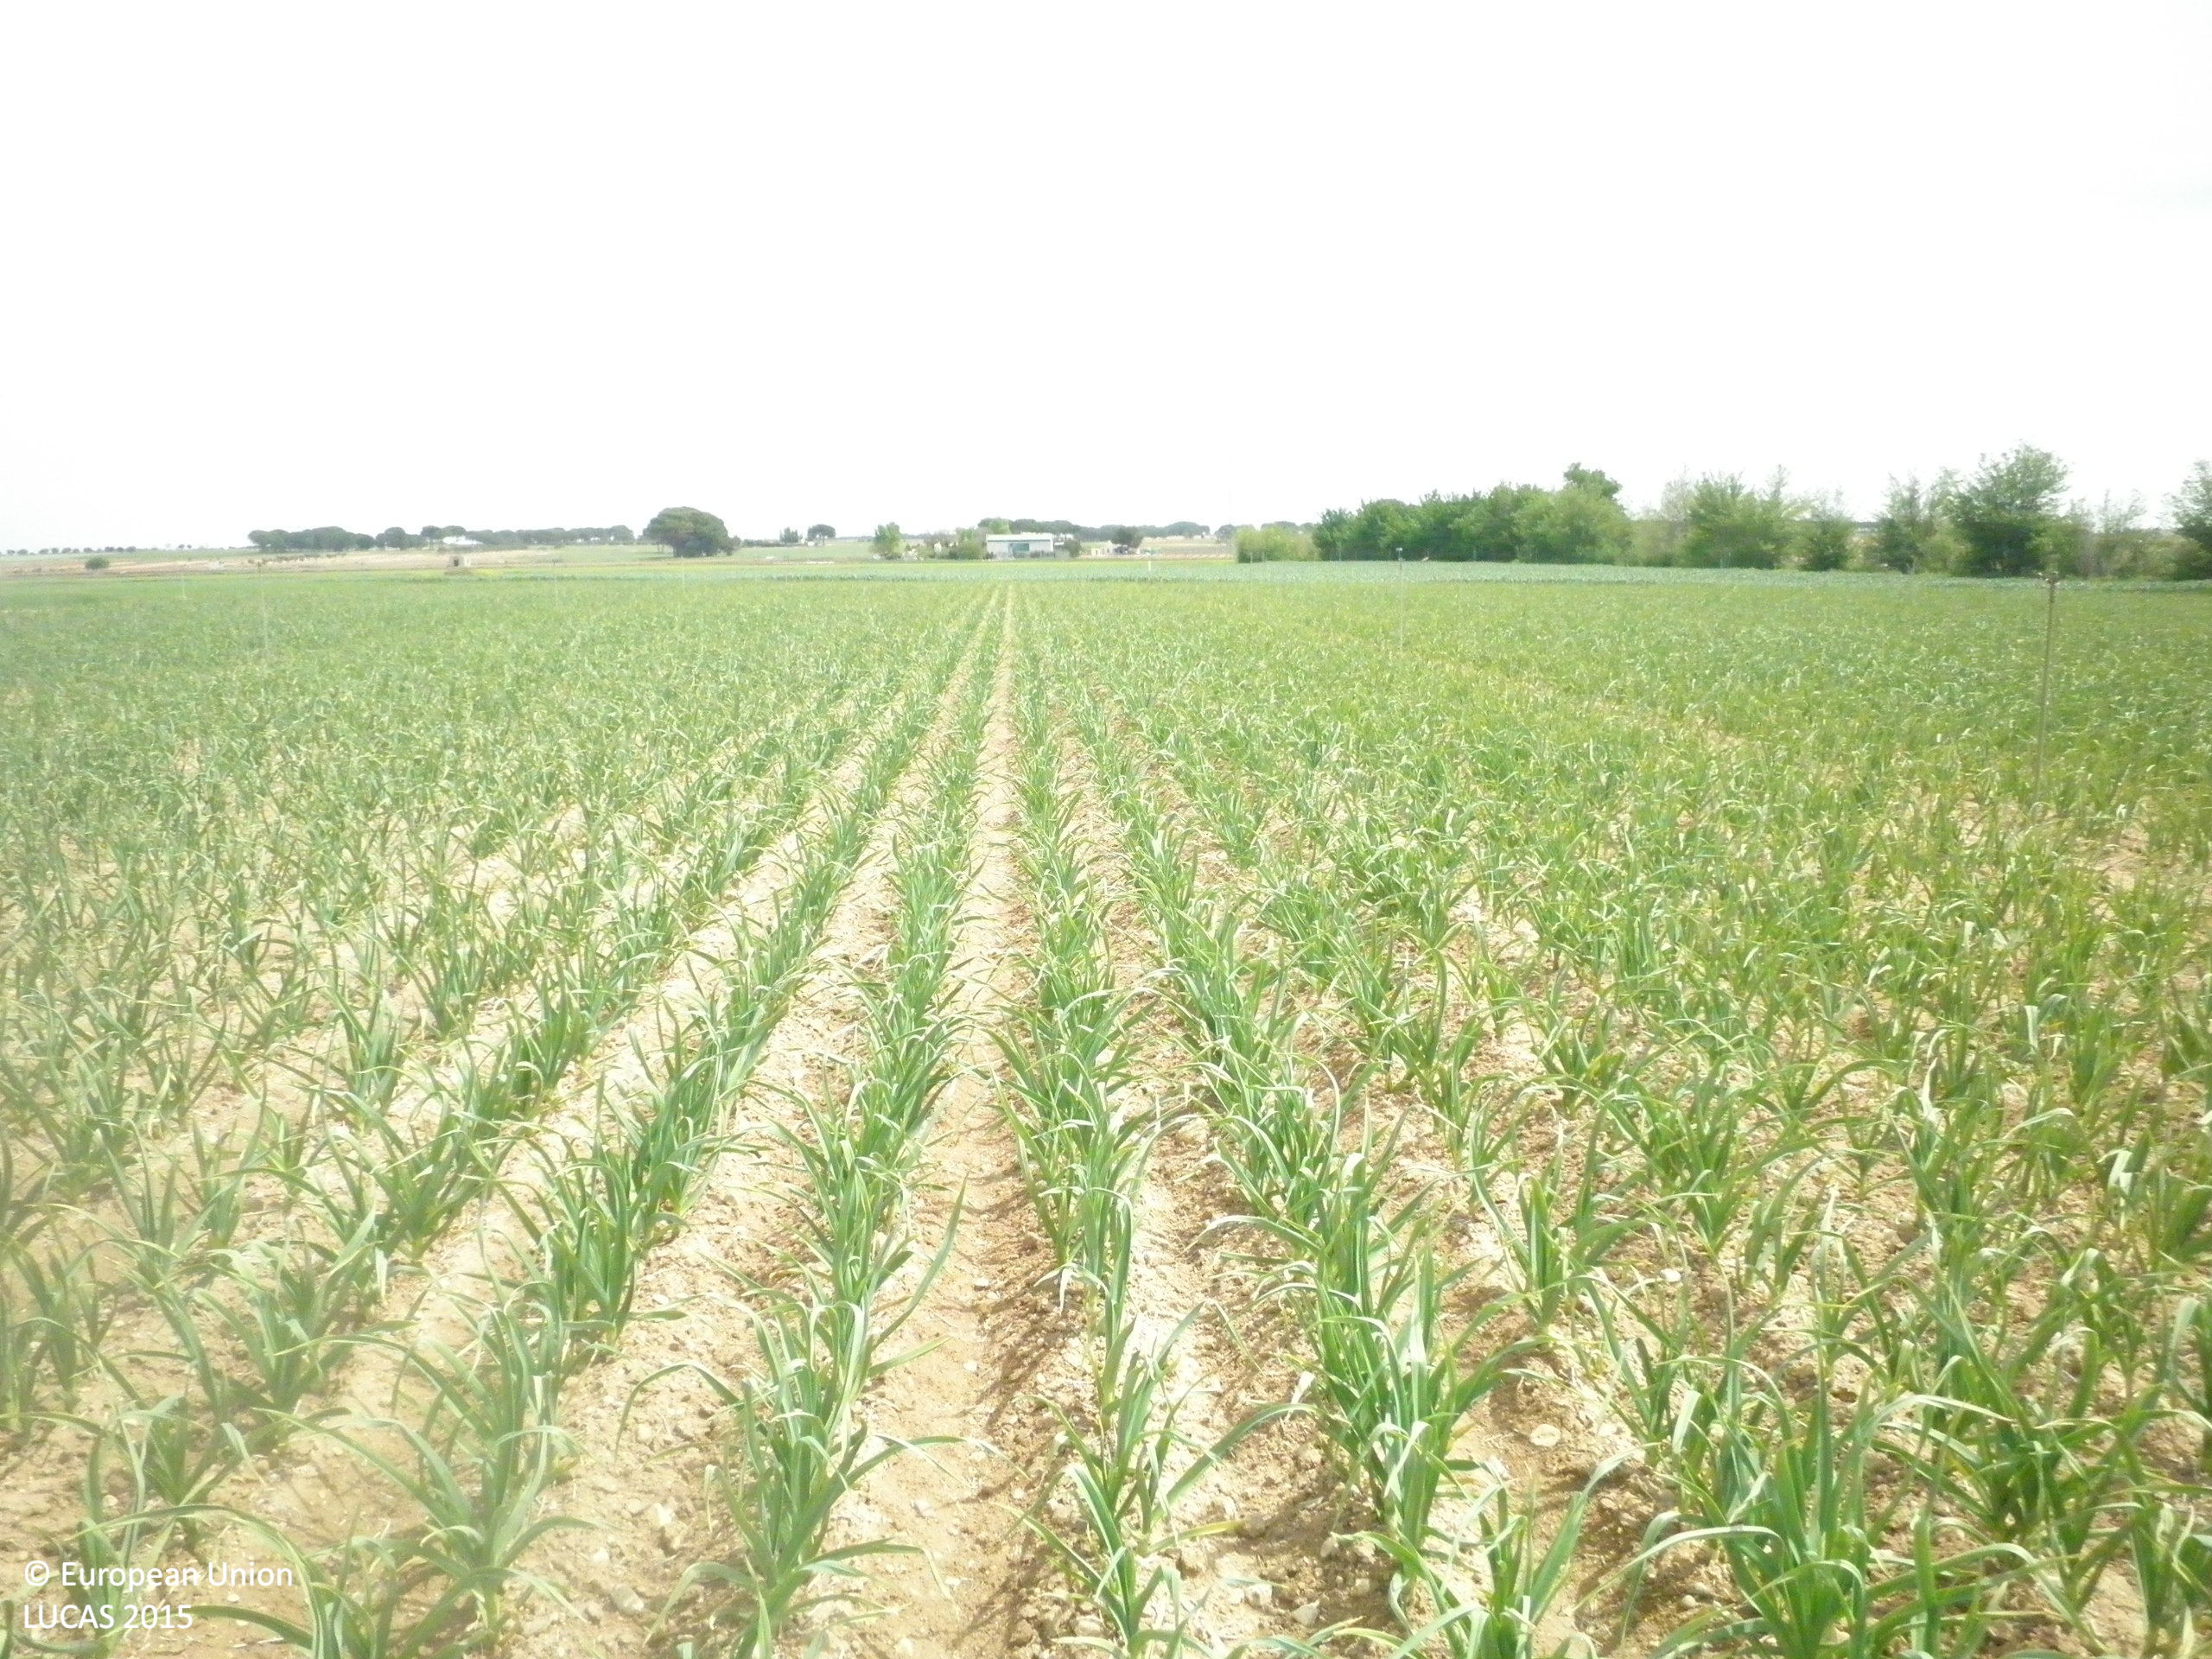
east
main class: Cropland
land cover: Other root crops
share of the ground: 10 - 25 %
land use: Agriculture (excluding fallow land and kitchen gardens)
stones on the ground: < 10 %
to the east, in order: Other root crops; Tracks; Other root crops; Spontaneously vegetated surfaces; Barley
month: April
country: ES
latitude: 39.4219
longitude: -2.6859
